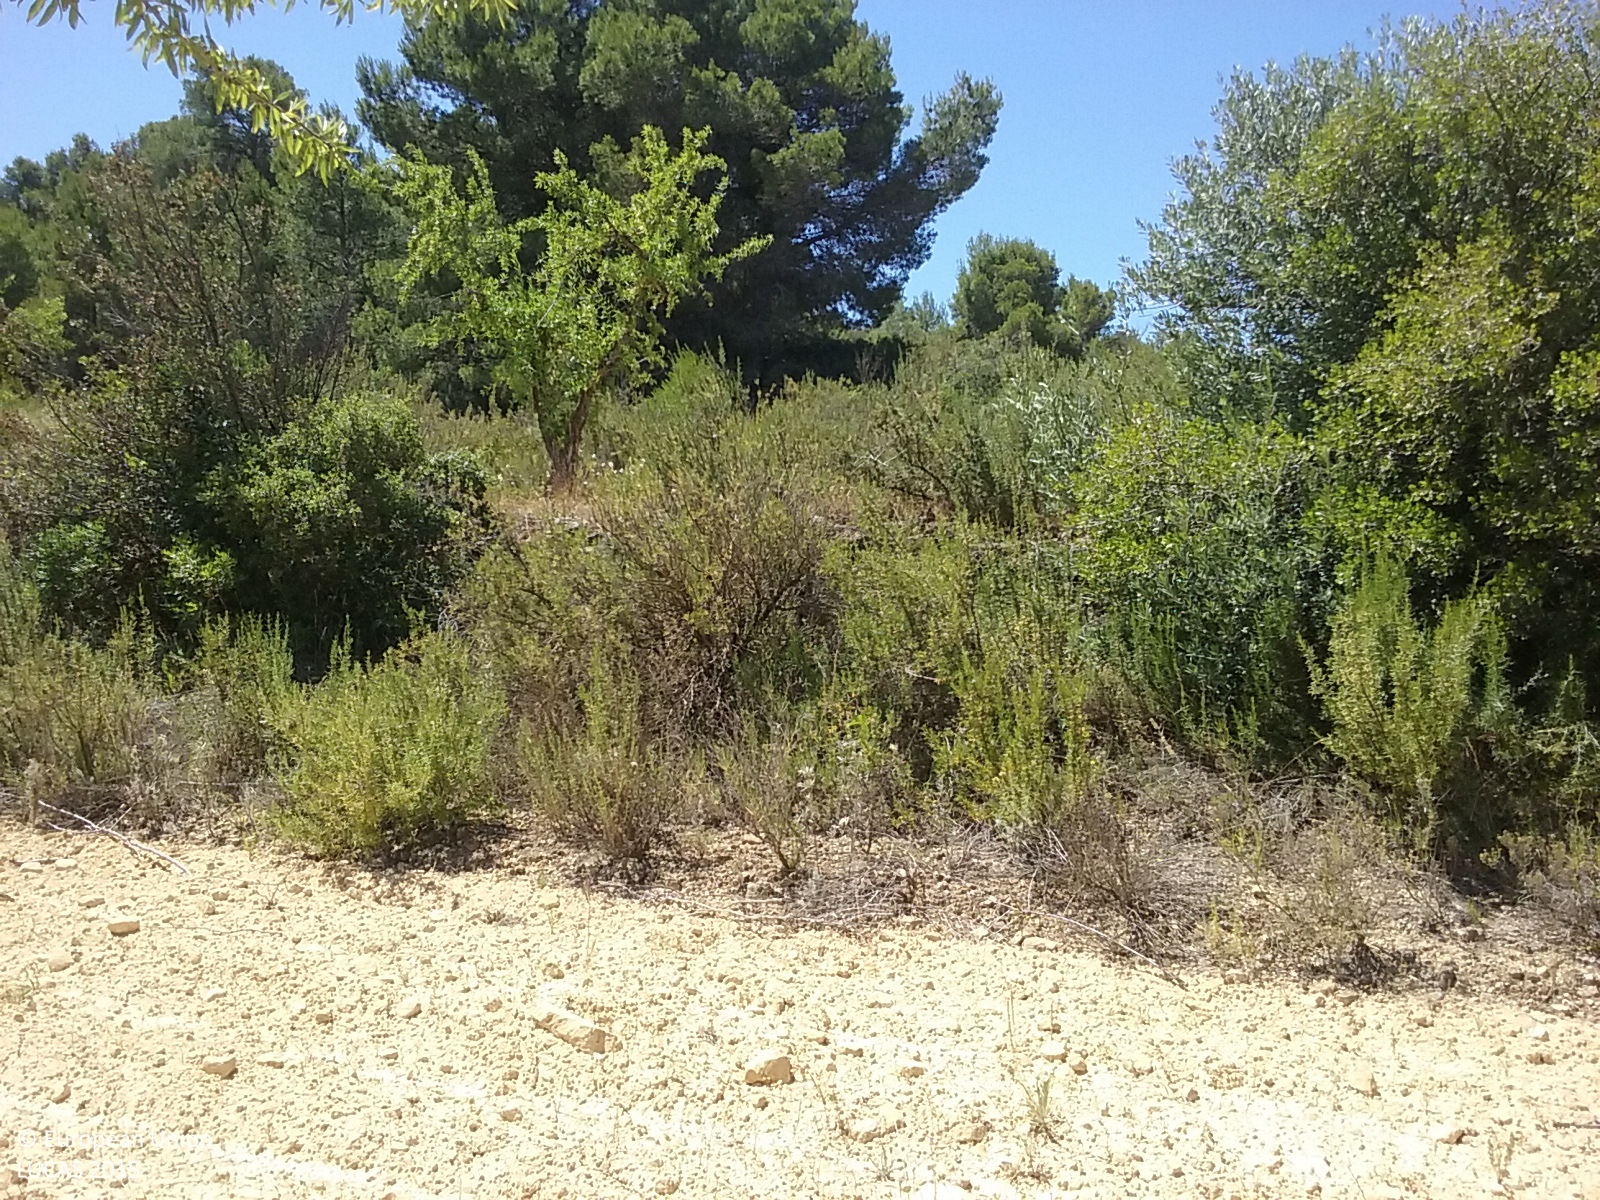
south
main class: Cropland
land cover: Nuts trees
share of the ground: 25 - 50 %
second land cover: Spontaneously vegetated surfaces
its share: 10 - 25 %
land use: Agriculture (excluding fallow land and kitchen gardens)
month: June
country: ES
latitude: 41.1153
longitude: 0.3081
